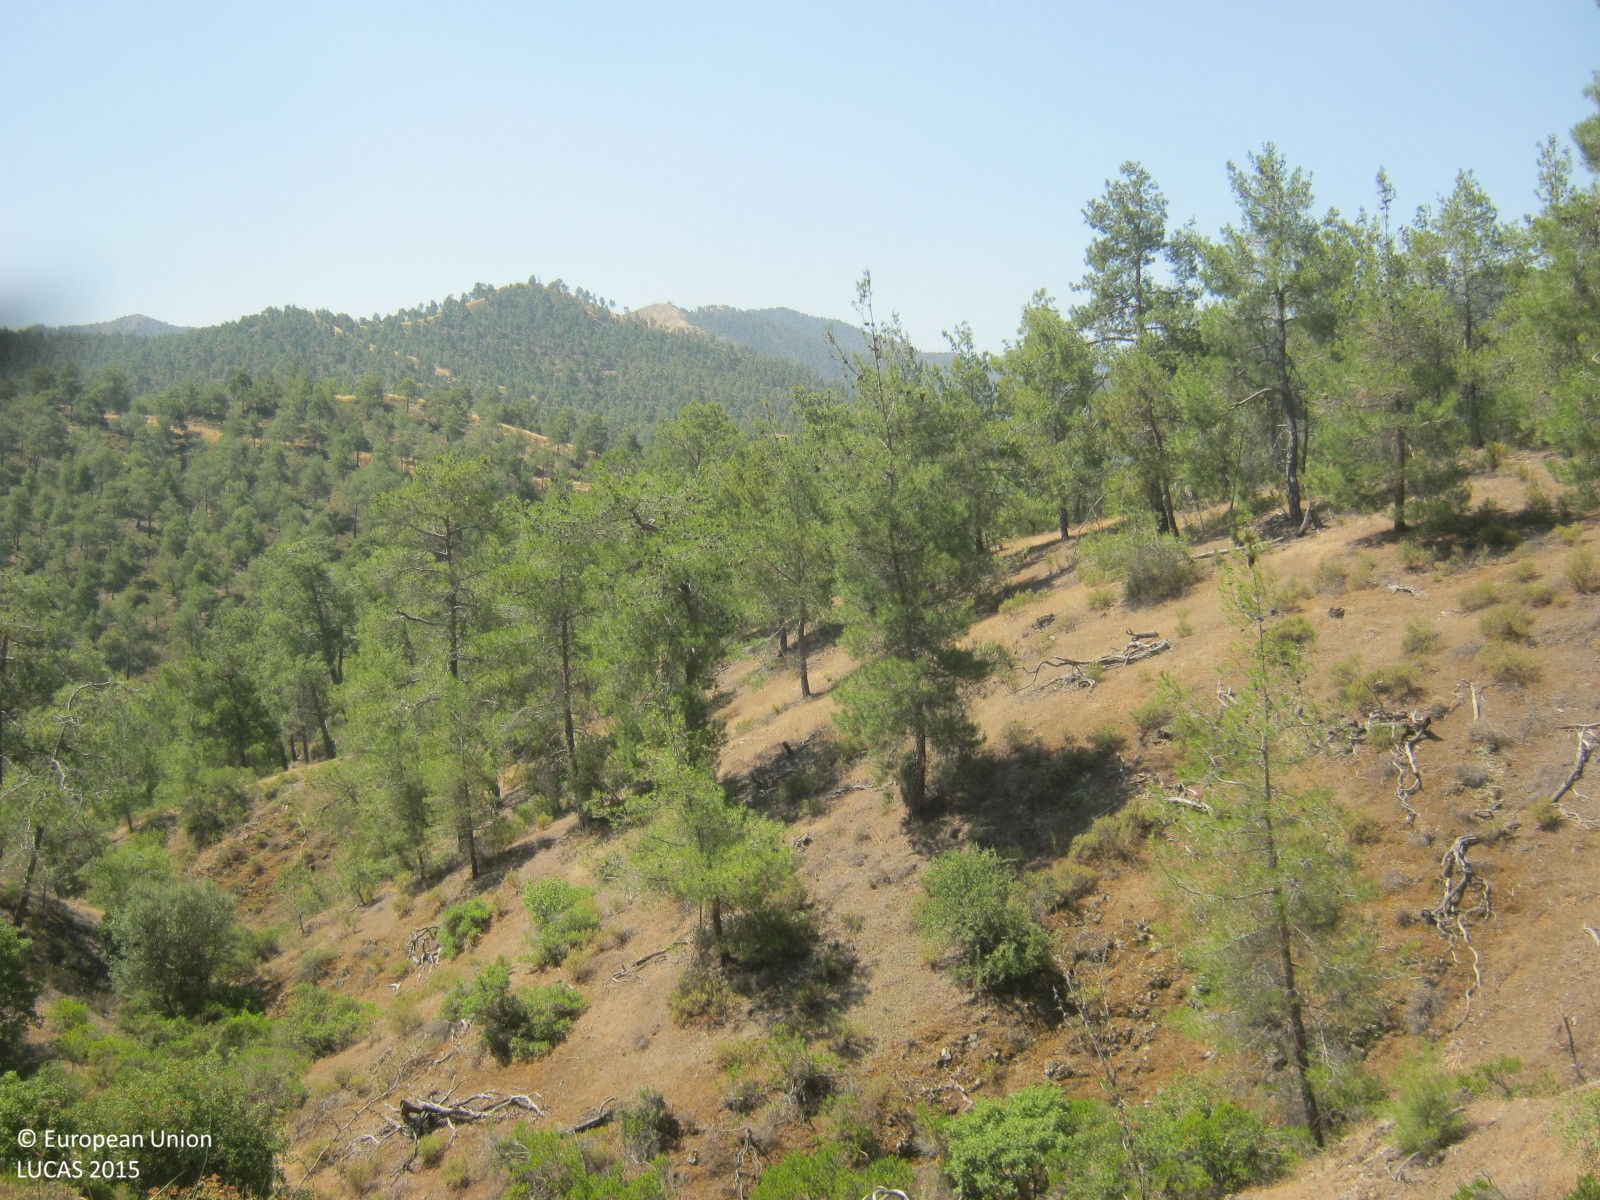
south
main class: Shrubland
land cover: Shrubland with sparse tree cover
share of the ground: 50 - 75 %
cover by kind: shrubs 50 %, herbaceous plants 35 %, unconsolidated bare surface 10 %, coniferous forest trees 5 %
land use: Forestry
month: June
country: CY
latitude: 35.0141
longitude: 33.0925
